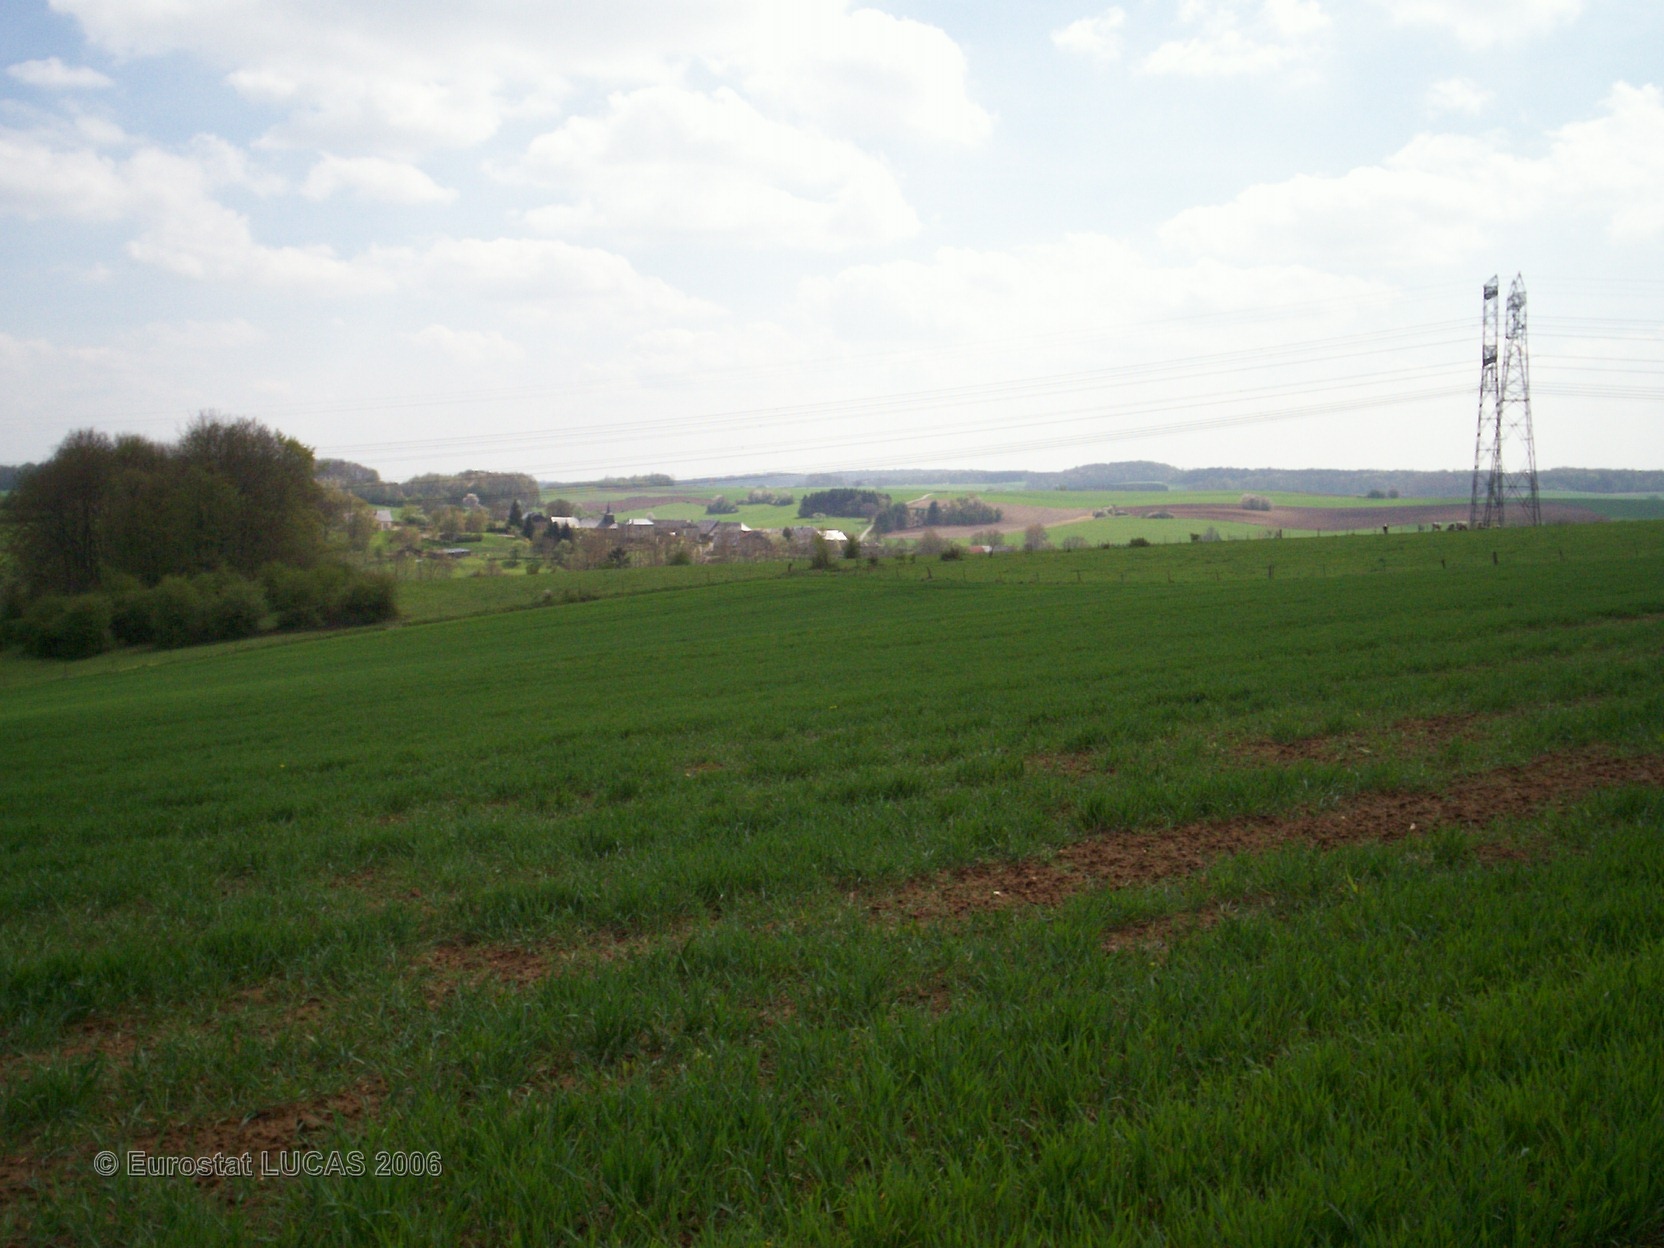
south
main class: Cropland
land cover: Common wheat
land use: Agriculture (excluding fallow land and kitchen gardens)
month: May
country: FR
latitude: 49.8107
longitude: 4.3676
